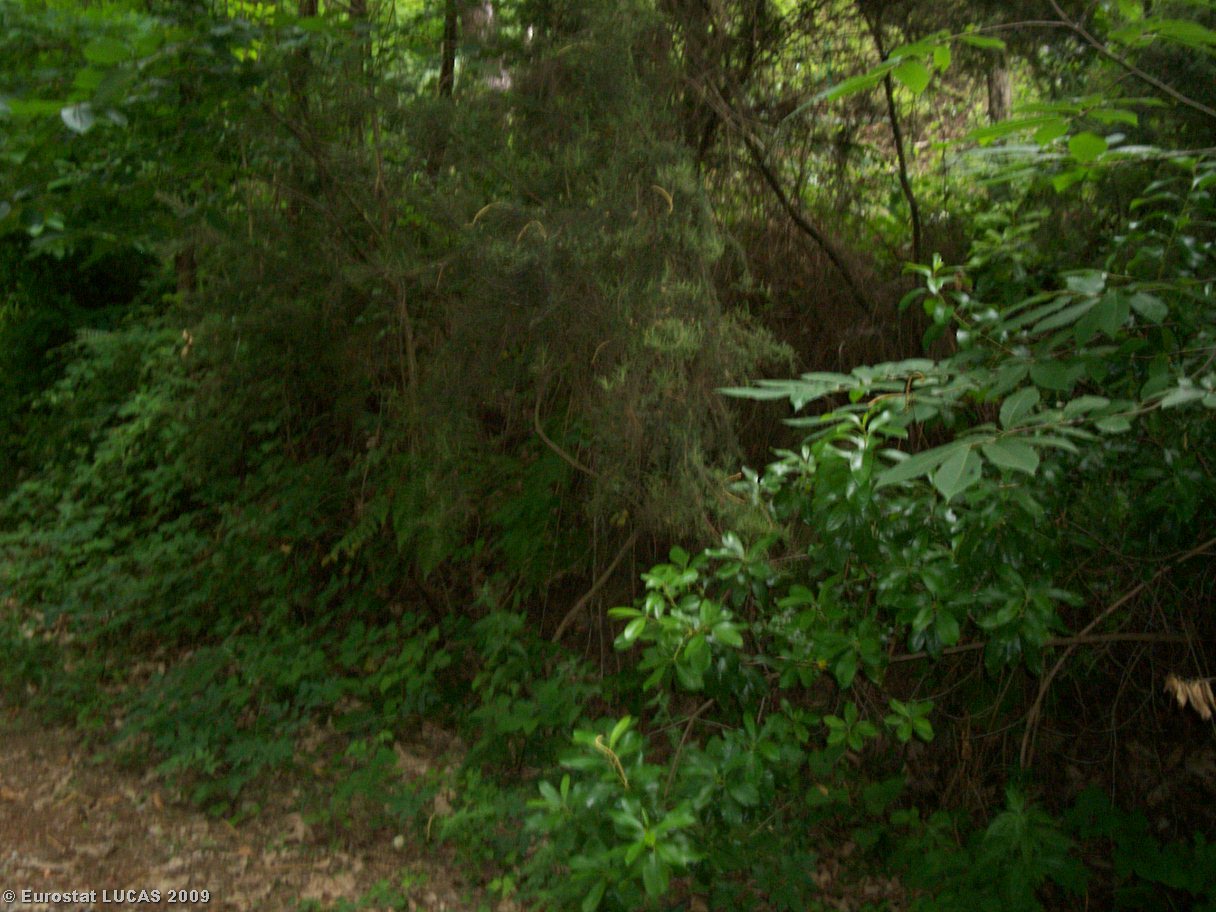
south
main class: Woodland
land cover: Broadleaved woodland
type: thermophilous deciduous forest
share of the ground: > 75 %
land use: Forestry
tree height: > 5 m
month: June
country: IT
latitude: 43.8990
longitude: 10.3353
